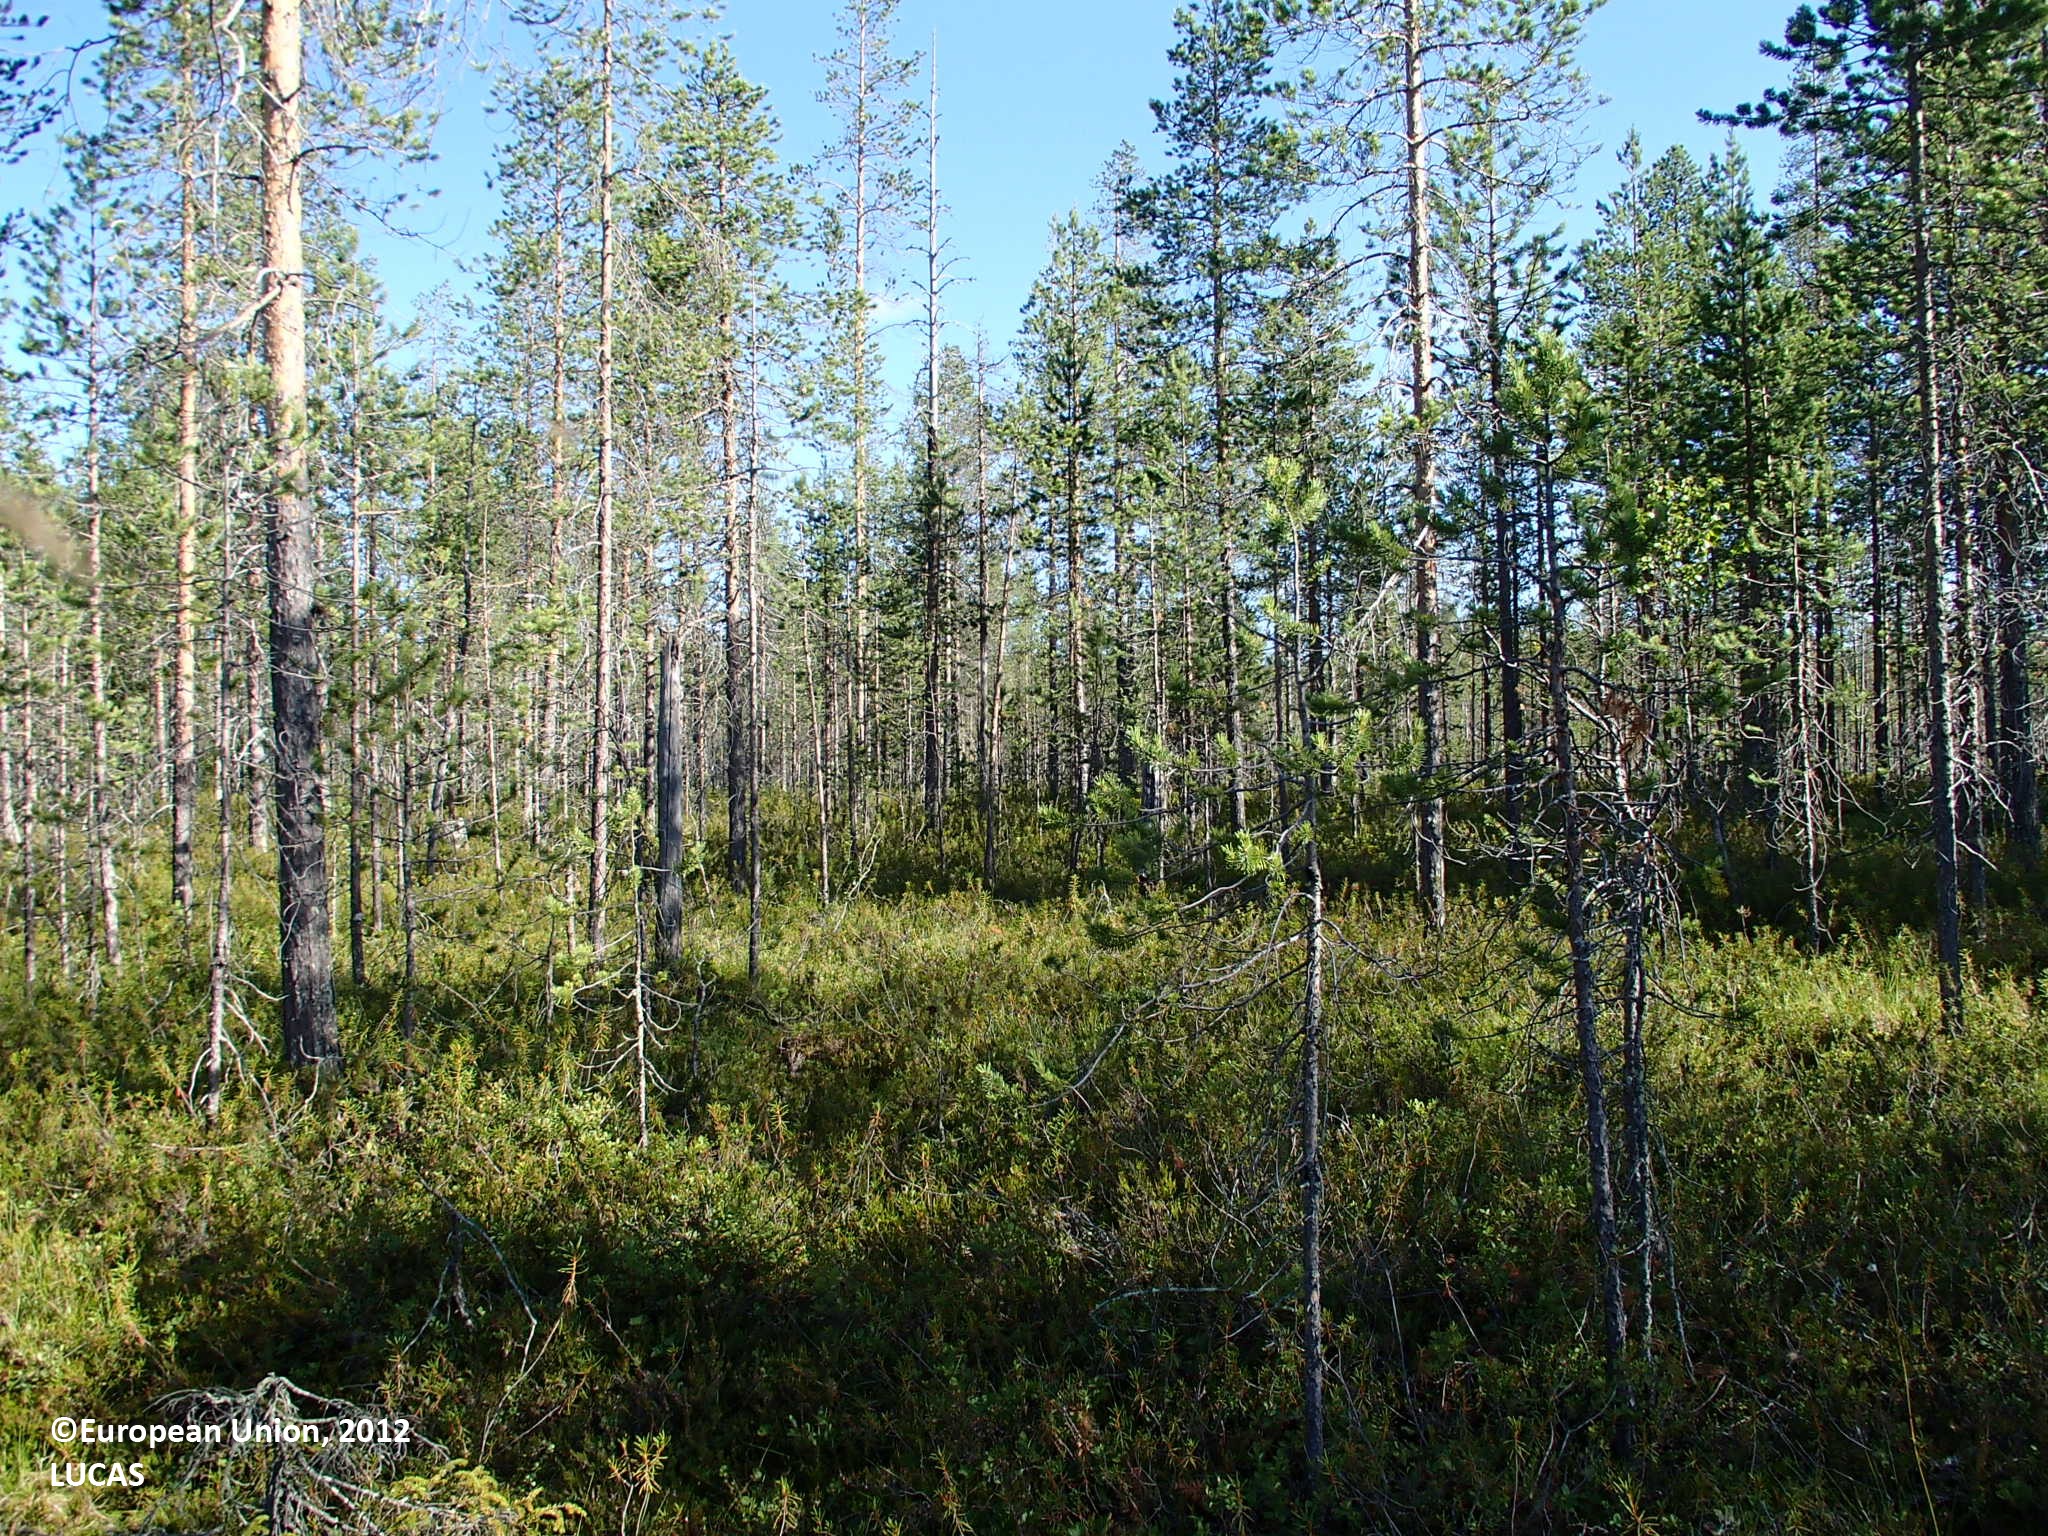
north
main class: Woodland
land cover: Pine dominated coniferous woodland
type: boreal forest
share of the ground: 10 - 25 %
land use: Forestry
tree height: > 5 m
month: July
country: FI
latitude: 66.8268
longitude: 25.5688
